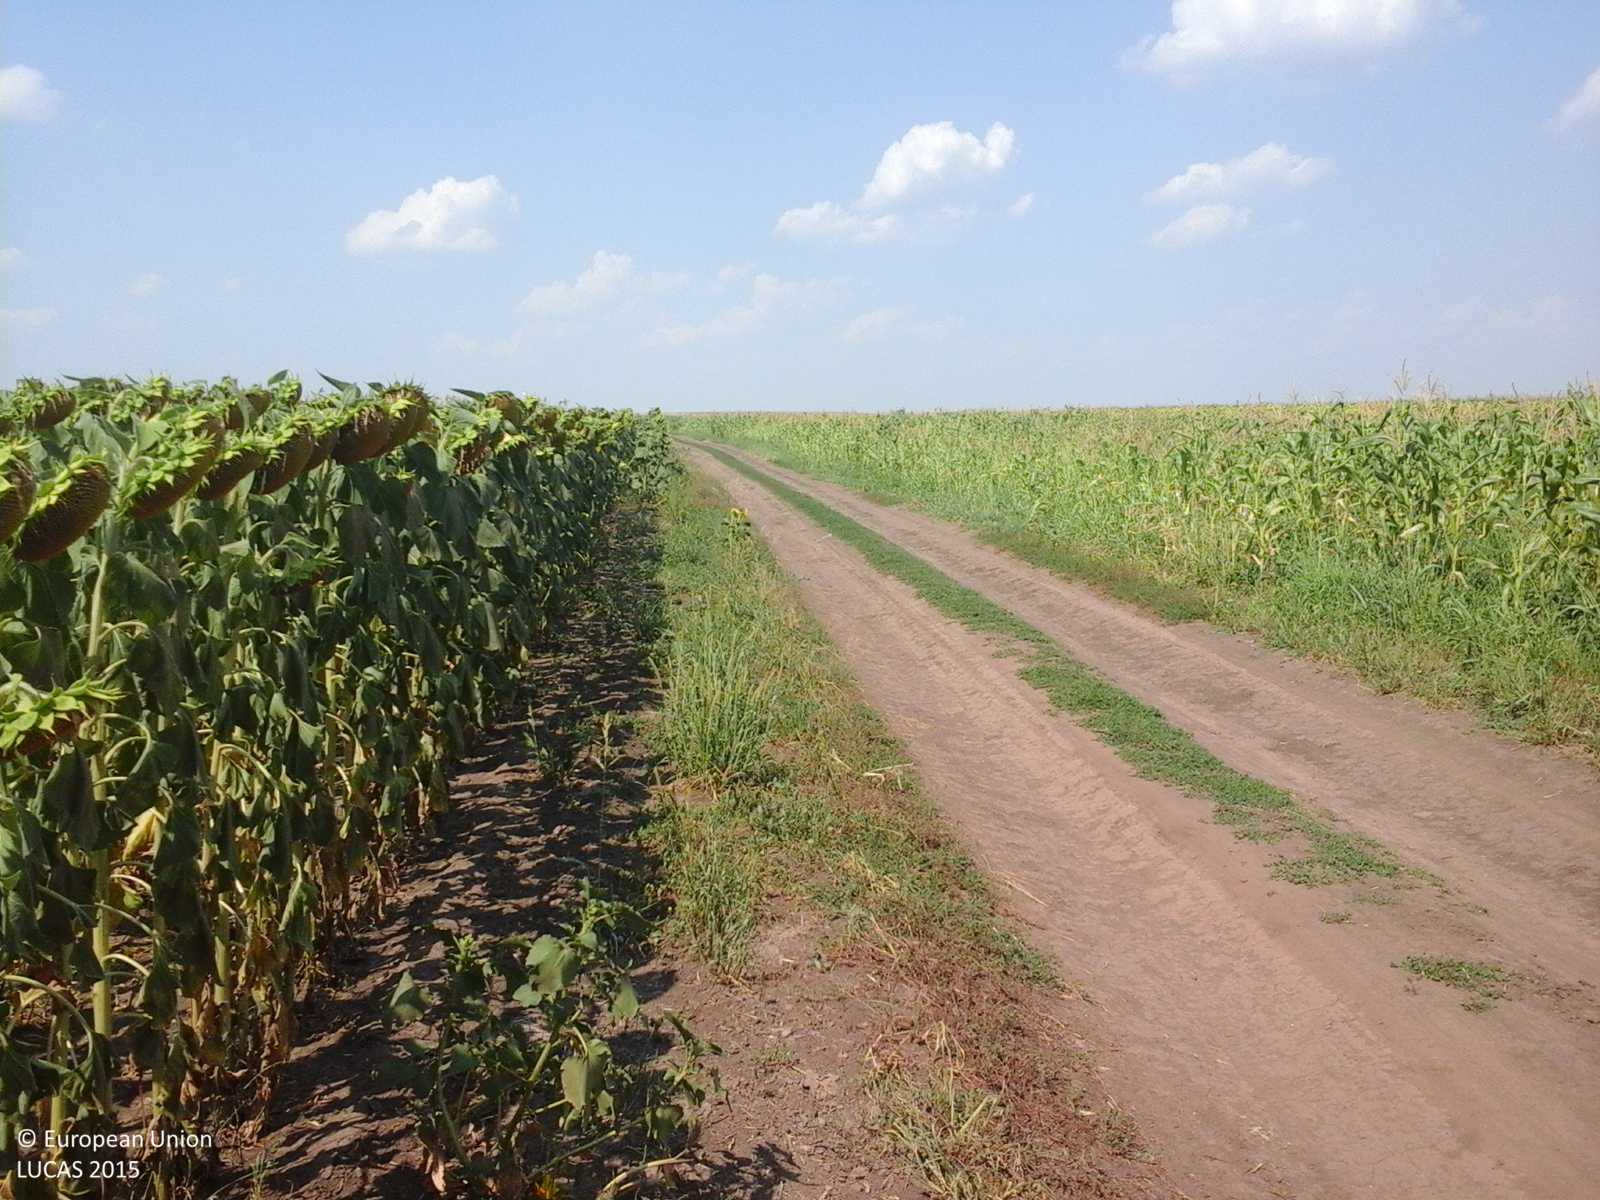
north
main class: Cropland
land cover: Sunflower
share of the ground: > 75 %
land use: Agriculture (excluding fallow land and kitchen gardens)
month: July
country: RO
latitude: 45.9122
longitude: 27.5770
